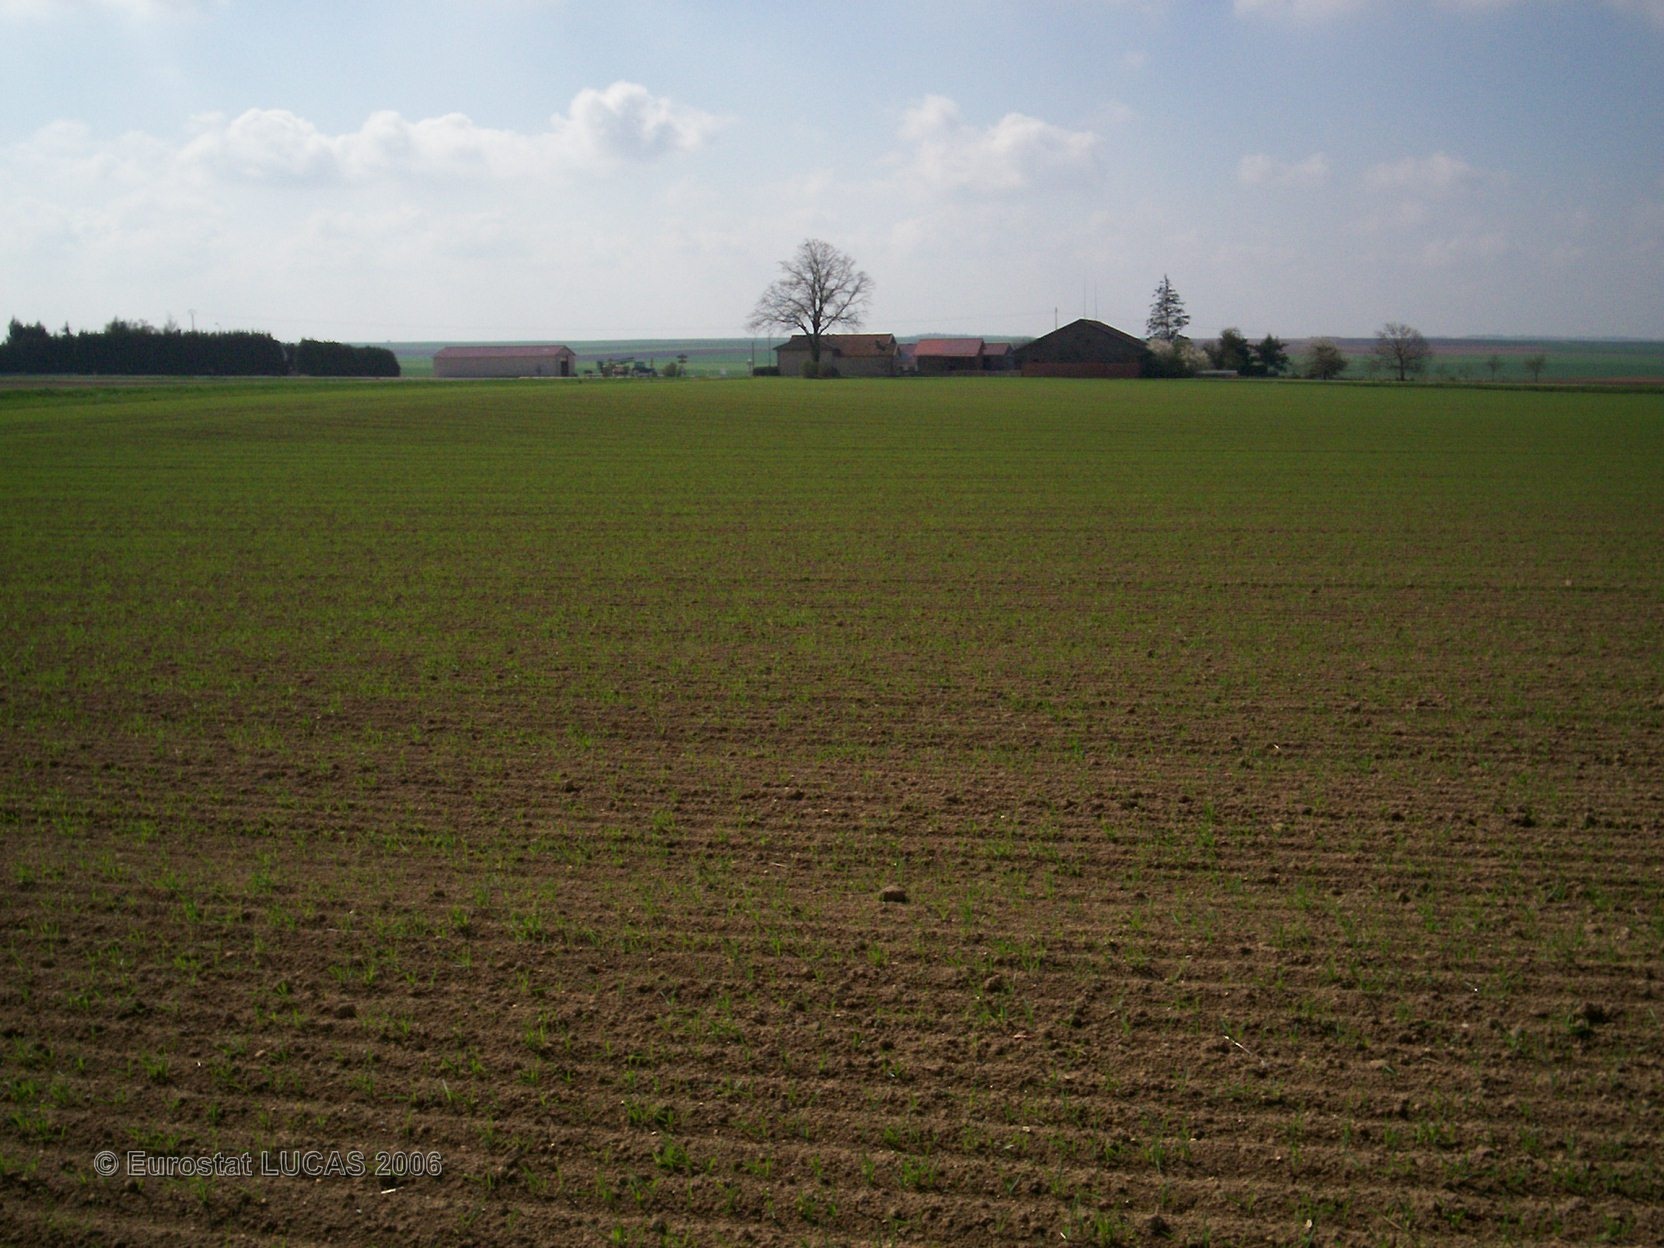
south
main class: Cropland
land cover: Barley
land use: Agriculture (excluding fallow land and kitchen gardens)
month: April
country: FR
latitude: 48.5198
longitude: 4.5140
